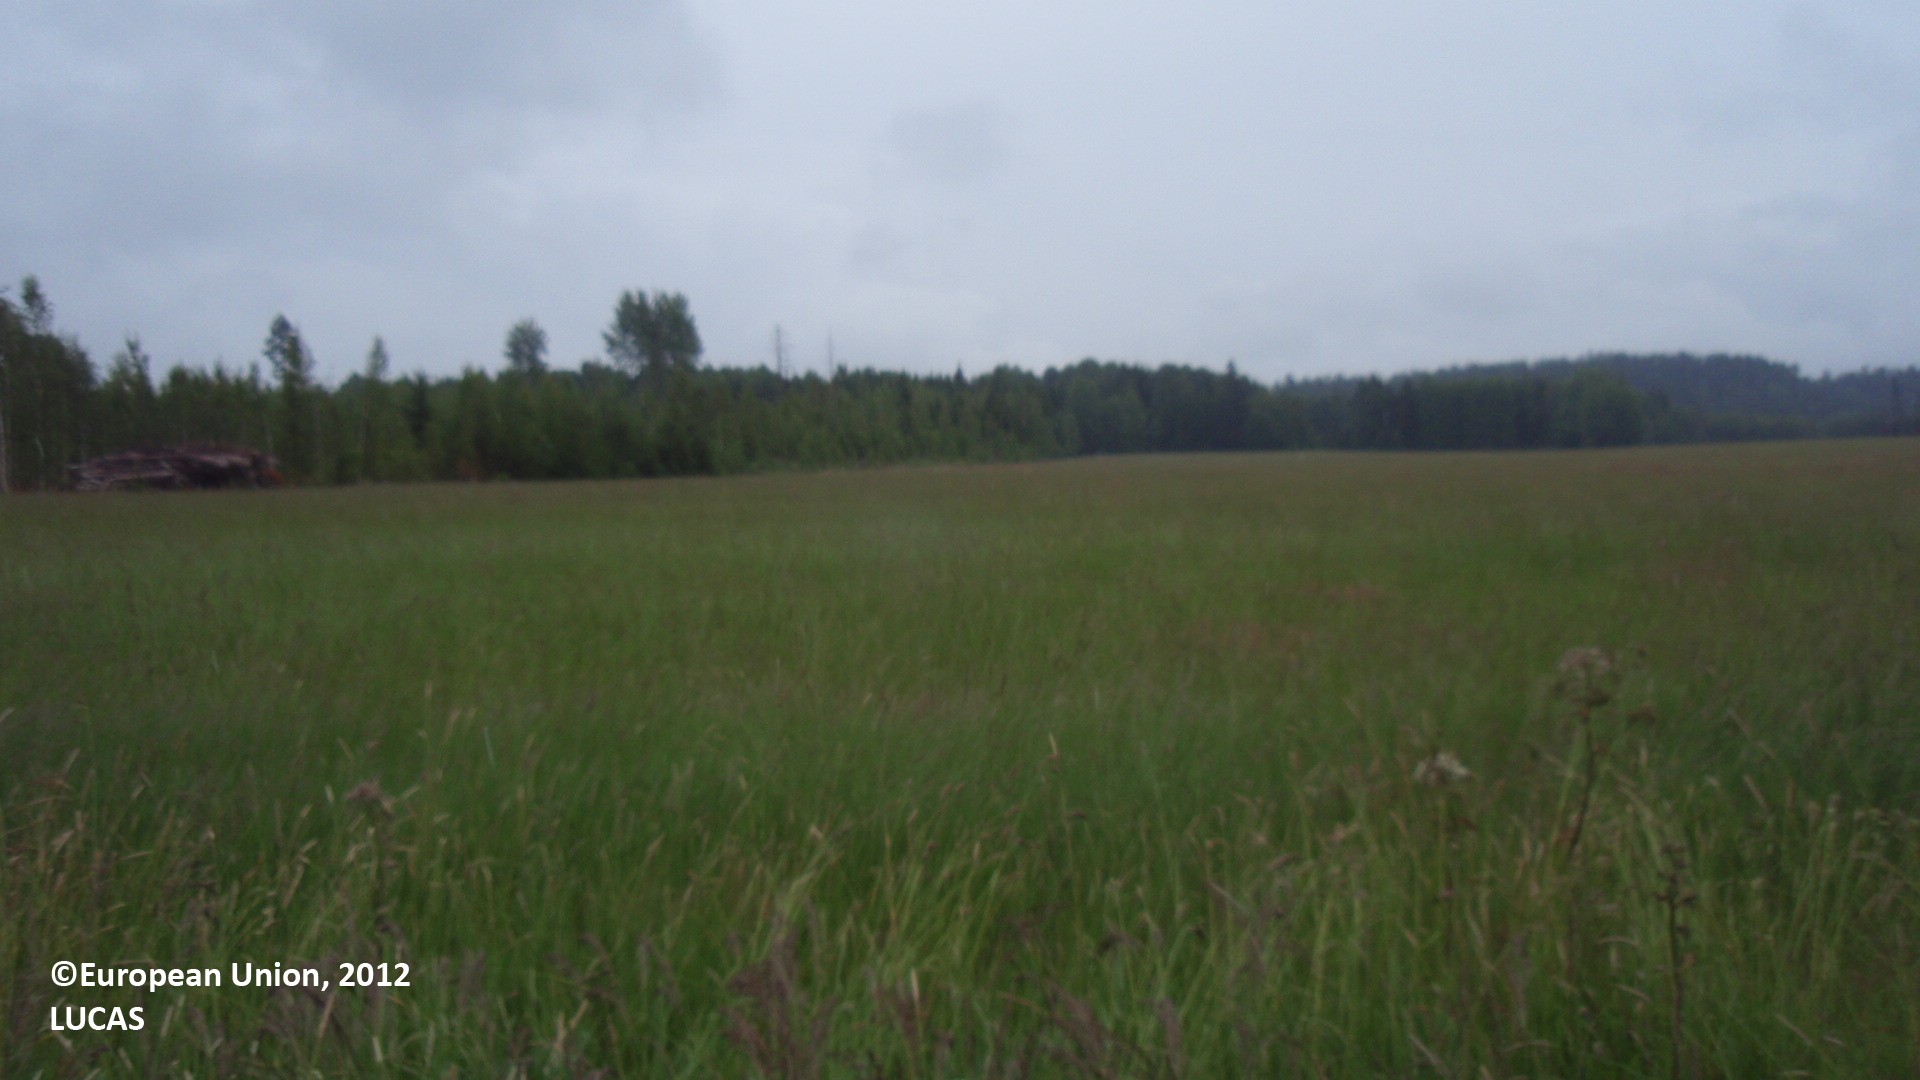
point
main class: Cropland
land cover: Oats
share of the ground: > 75 %
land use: Agriculture (excluding fallow land and kitchen gardens)
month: July
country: FI
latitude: 61.0987
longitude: 28.7551
